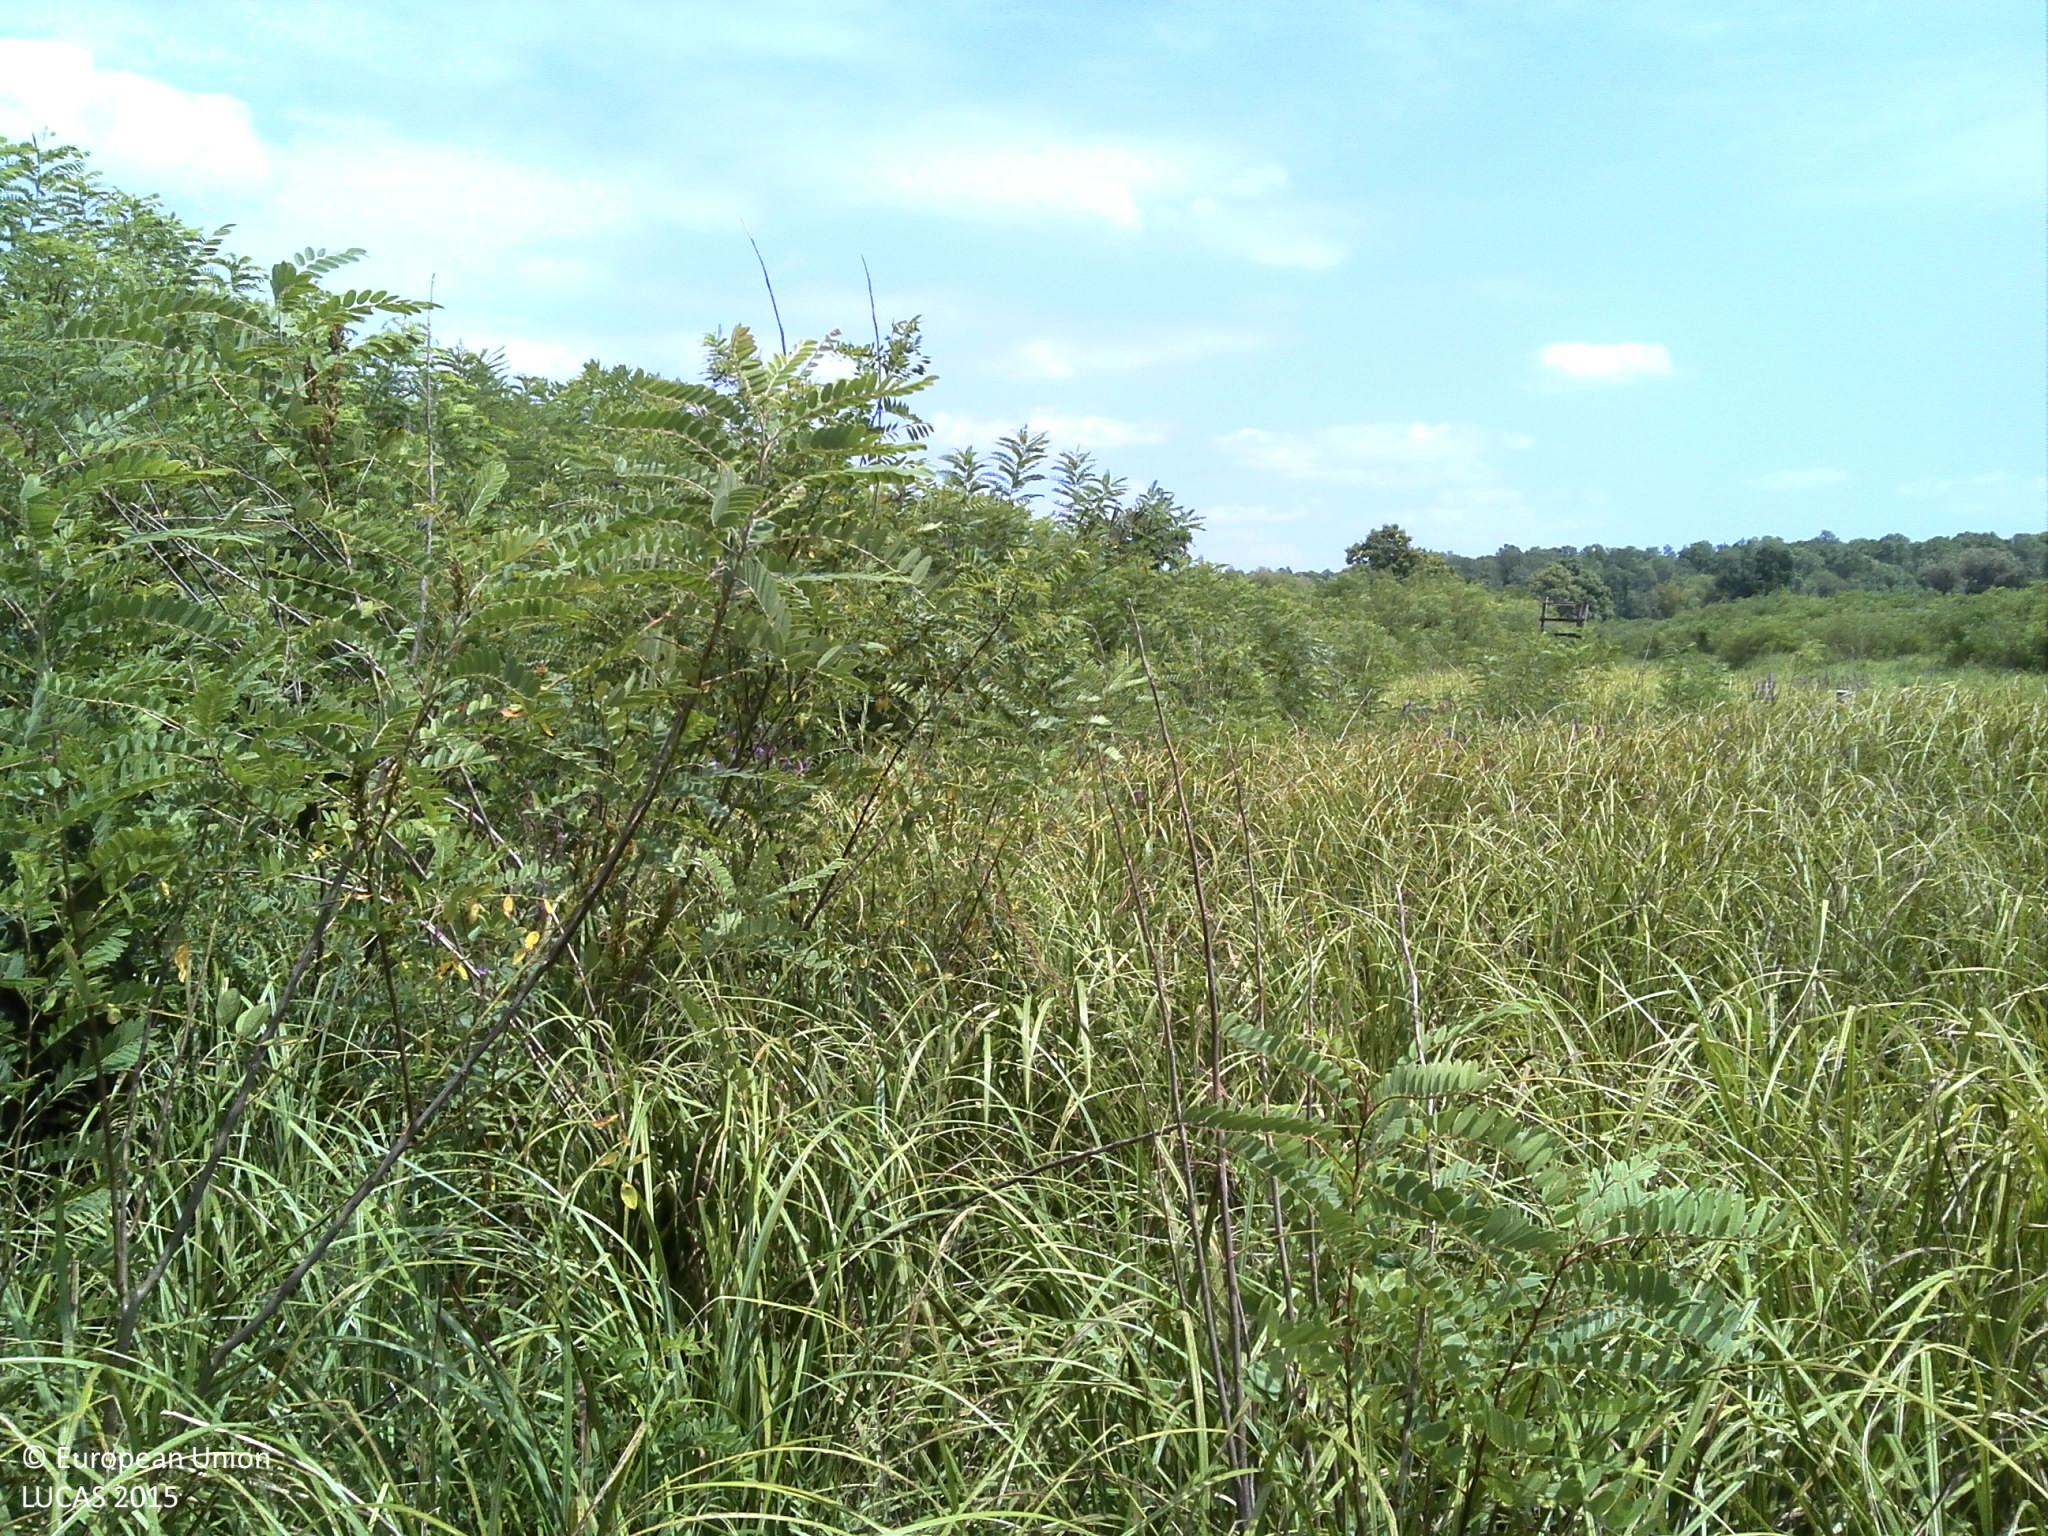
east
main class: Grassland
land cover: Grassland without tree/shrub cover
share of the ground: > 75 %
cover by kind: herbaceous plants 100 %
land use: Semi-natural and natural areas not in use
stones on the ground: < 10 %
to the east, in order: Grassland without tree/shrub cover; Shrubland with sparse tree cover
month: August
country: HR
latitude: 45.4942
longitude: 16.6398
